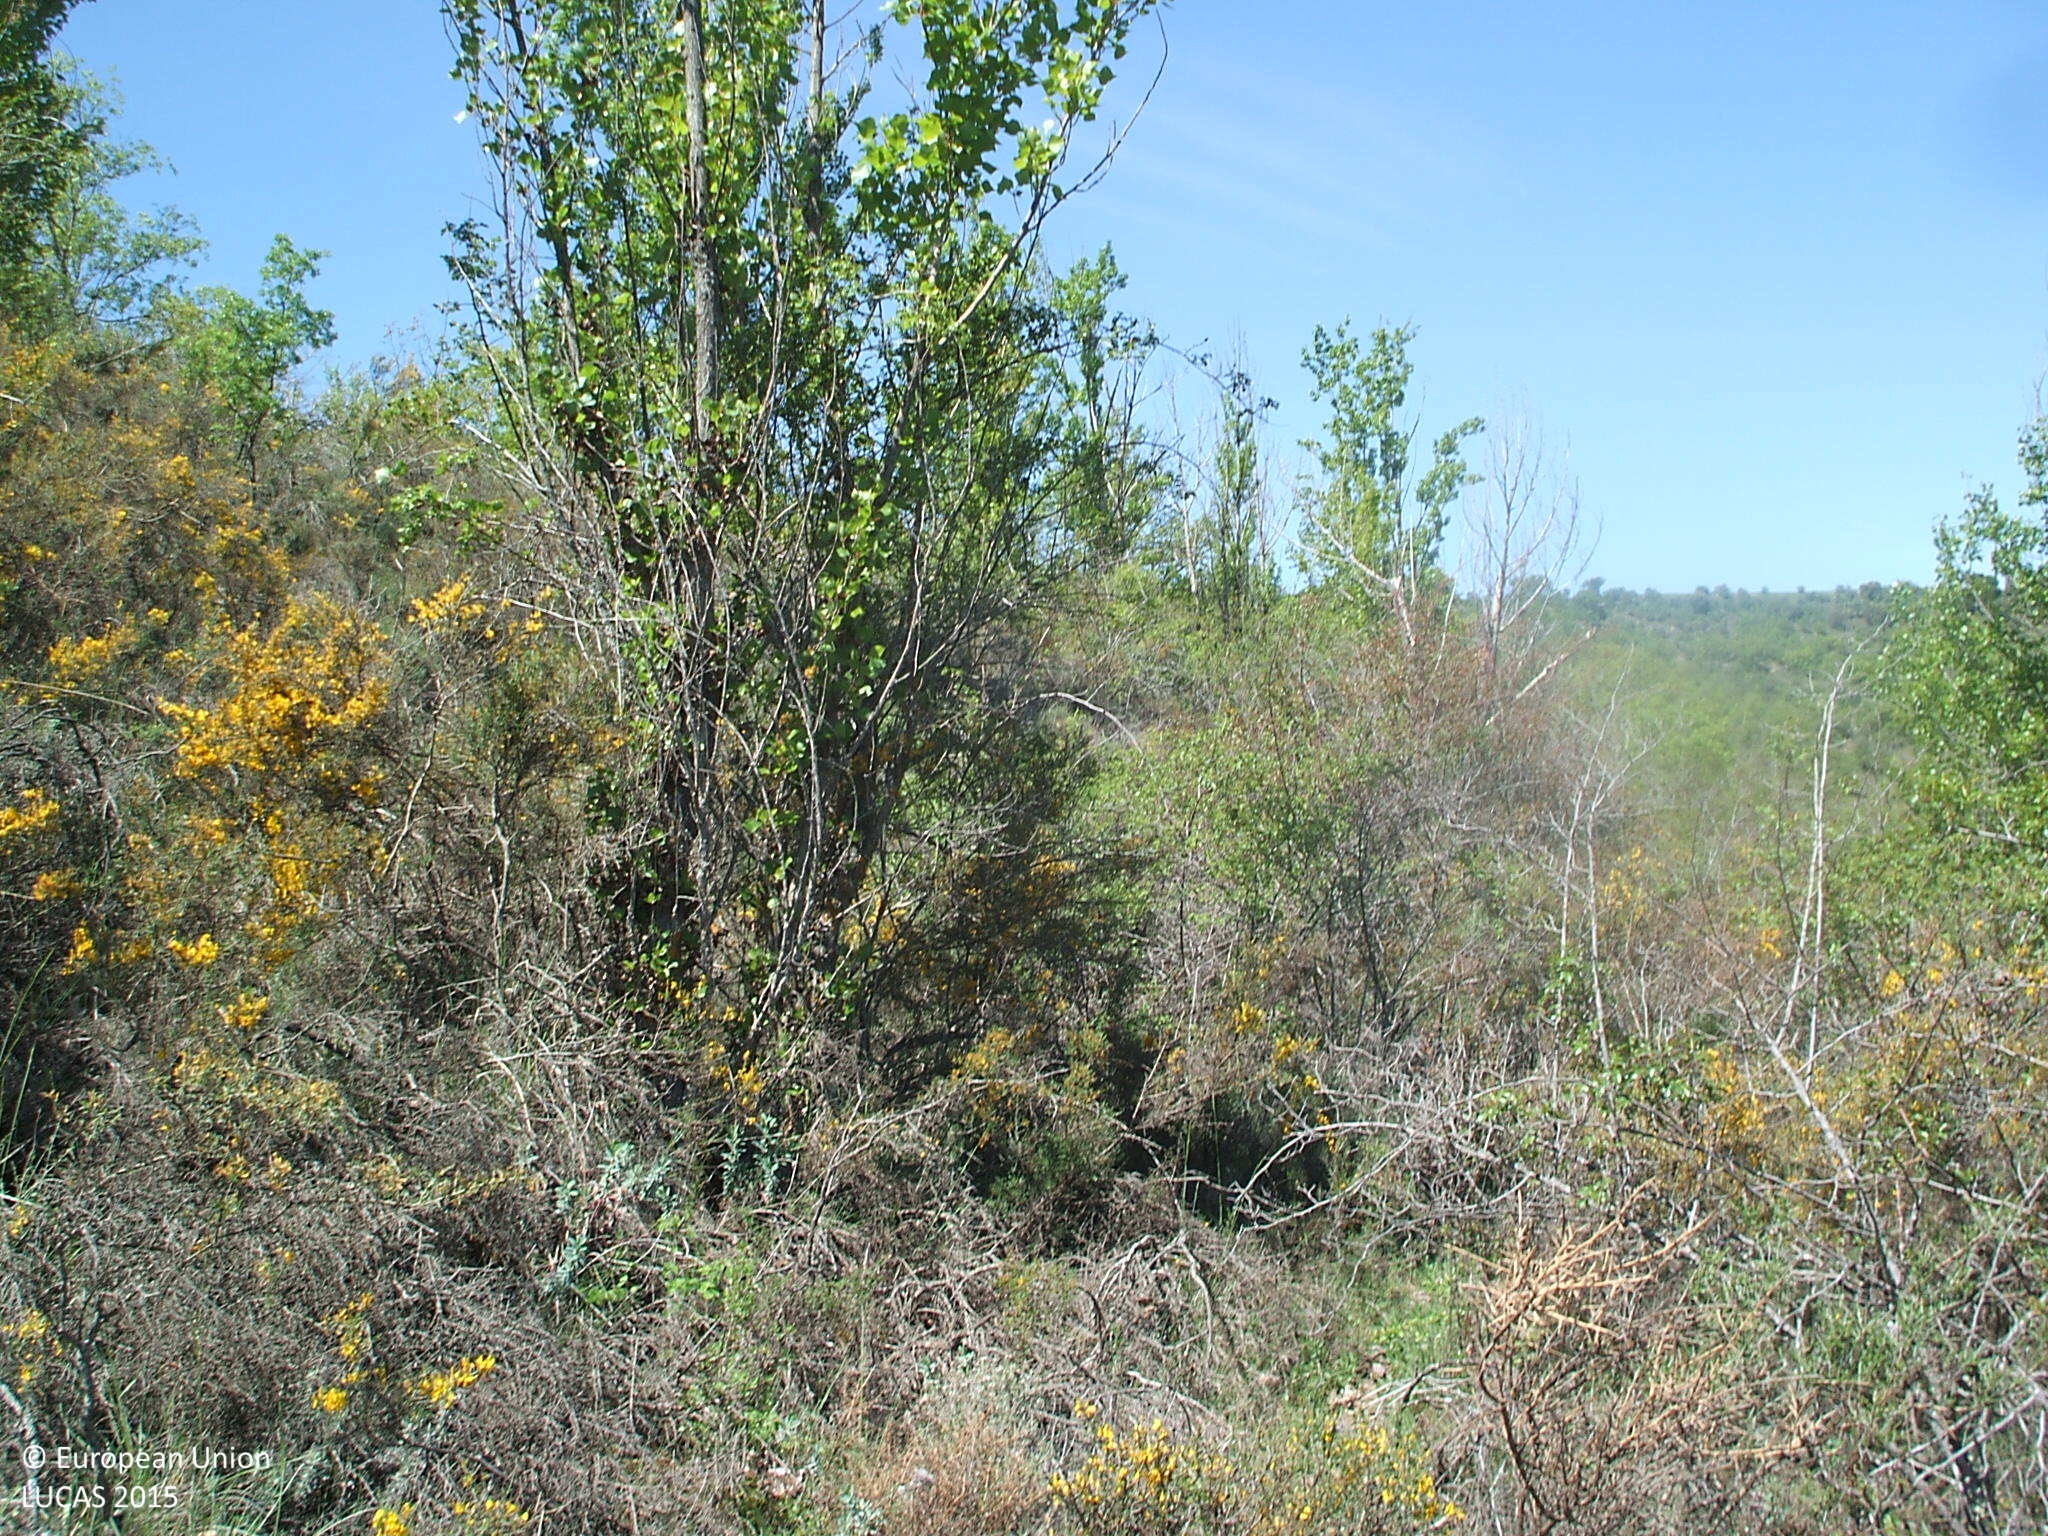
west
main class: Shrubland
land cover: Shrubland with sparse tree cover
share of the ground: > 75 %
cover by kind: shrubs 95 %, broadleaved forest trees 5 %
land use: Semi-natural and natural areas not in use
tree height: > 5 m
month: May
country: ES
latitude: 40.7403
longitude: -2.9519
